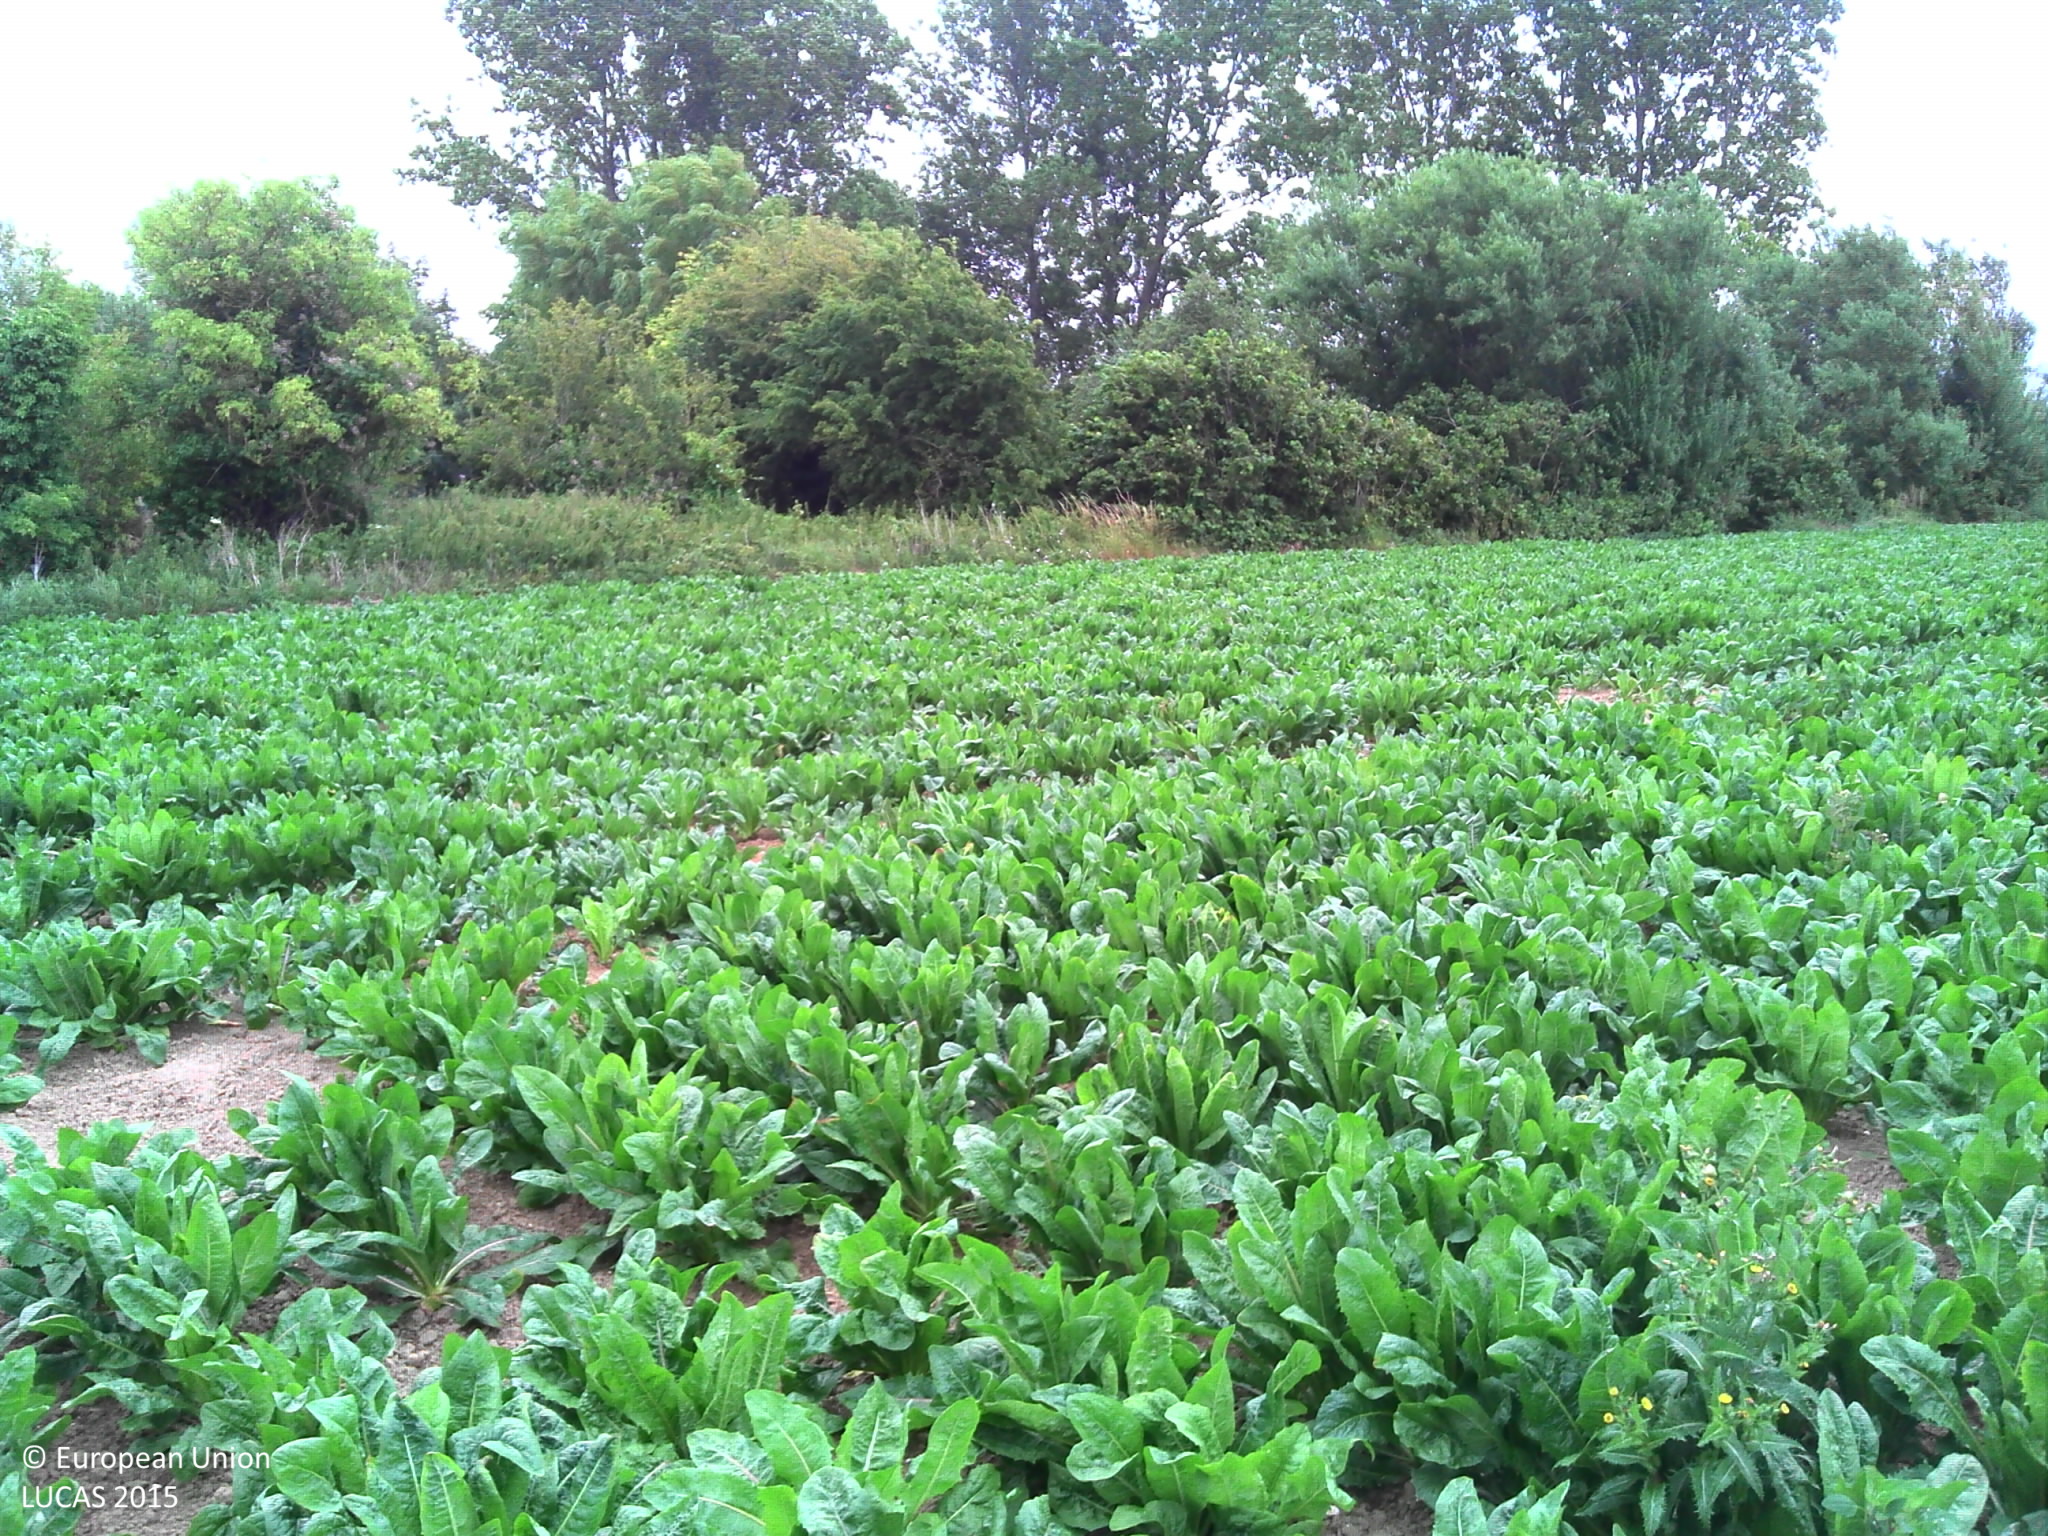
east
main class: Cropland
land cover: Sugar beet
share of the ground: > 75 %
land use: Agriculture (excluding fallow land and kitchen gardens)
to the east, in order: Sugar beet; Abandoned hedges; Fences; Grassland with sparse tree/shrub cover; Broadleaved woodland; Artificial constructions in urban areas; Potatoes; Electric lines; Grass margins; Paved roads, cycling and walking lanes; Grass margins; Potatoes
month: July
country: FR
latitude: 50.8686
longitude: 2.3845
